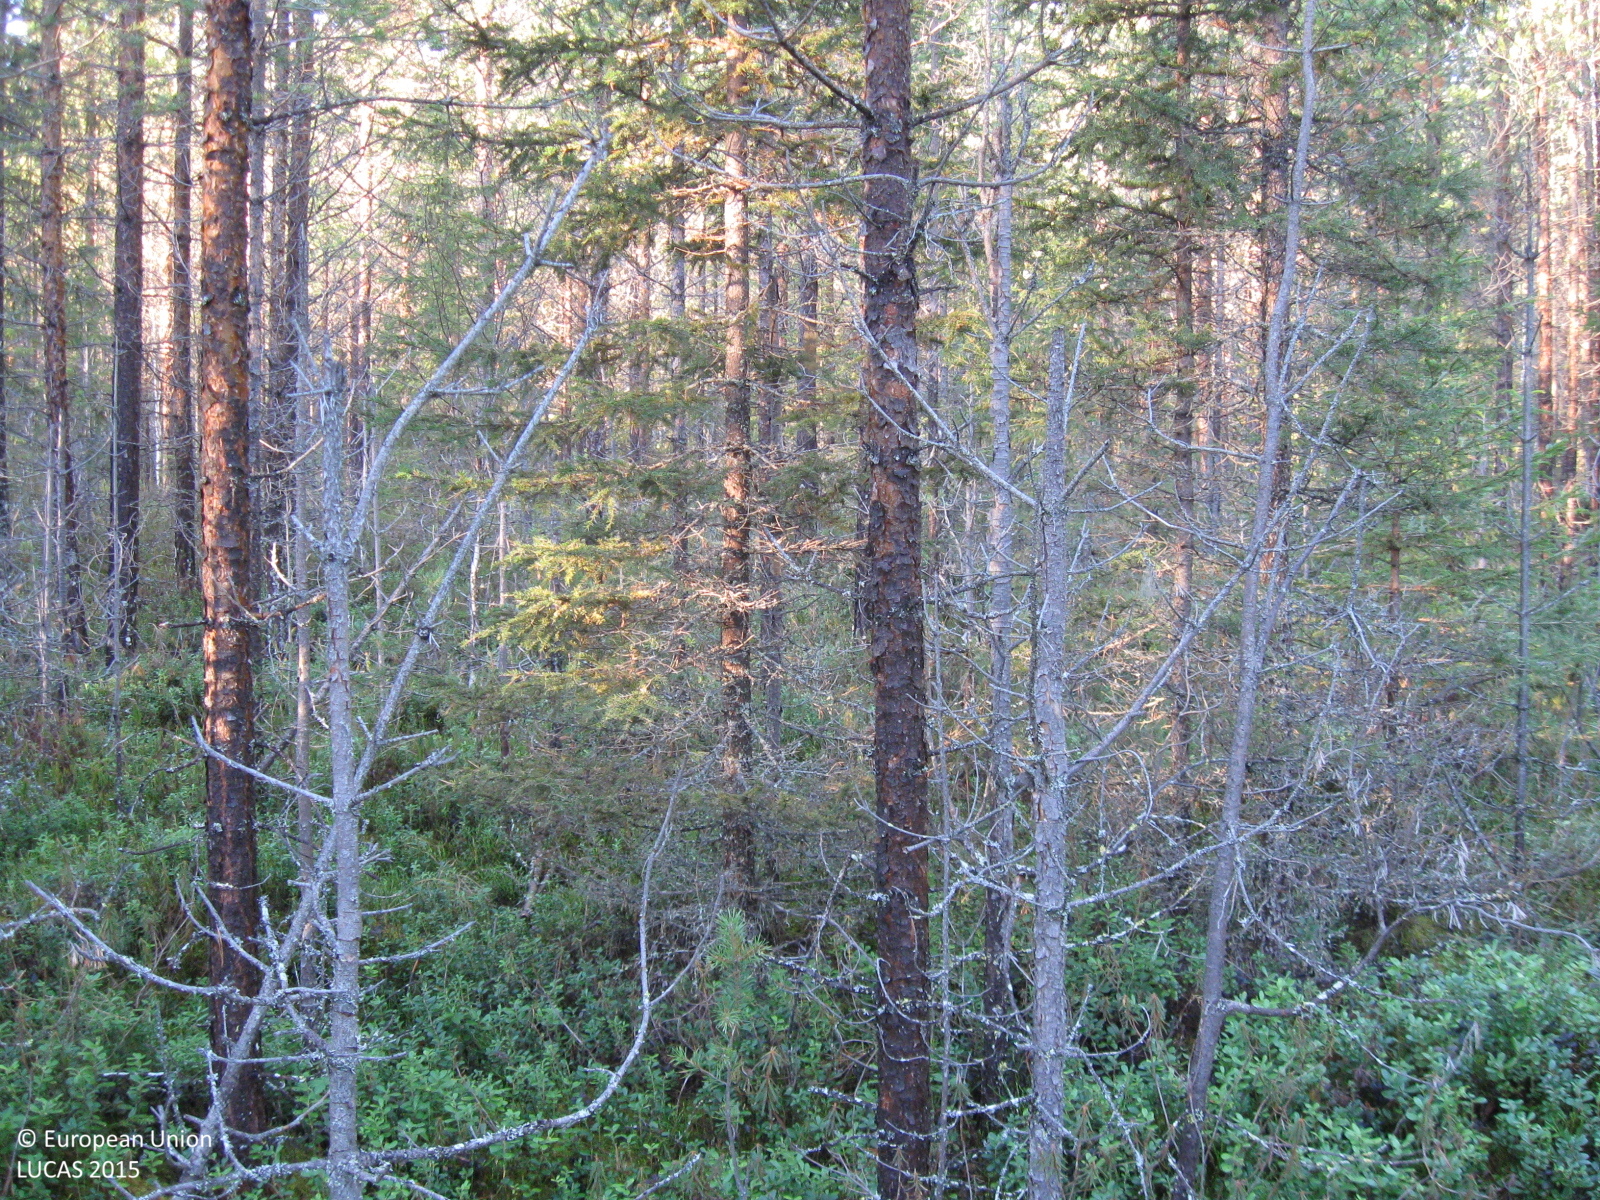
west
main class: Woodland
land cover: Pine dominated coniferous woodland
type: boreal forest
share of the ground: > 75 %
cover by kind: coniferous forest trees 80 %, broadleaved forest trees 5 %, shrubs 5 %, herbaceous plants 5 %, lichens and mosses 5 %
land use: Forestry
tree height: > 5 m
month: November
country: SE
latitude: 66.1640
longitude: 20.8503
